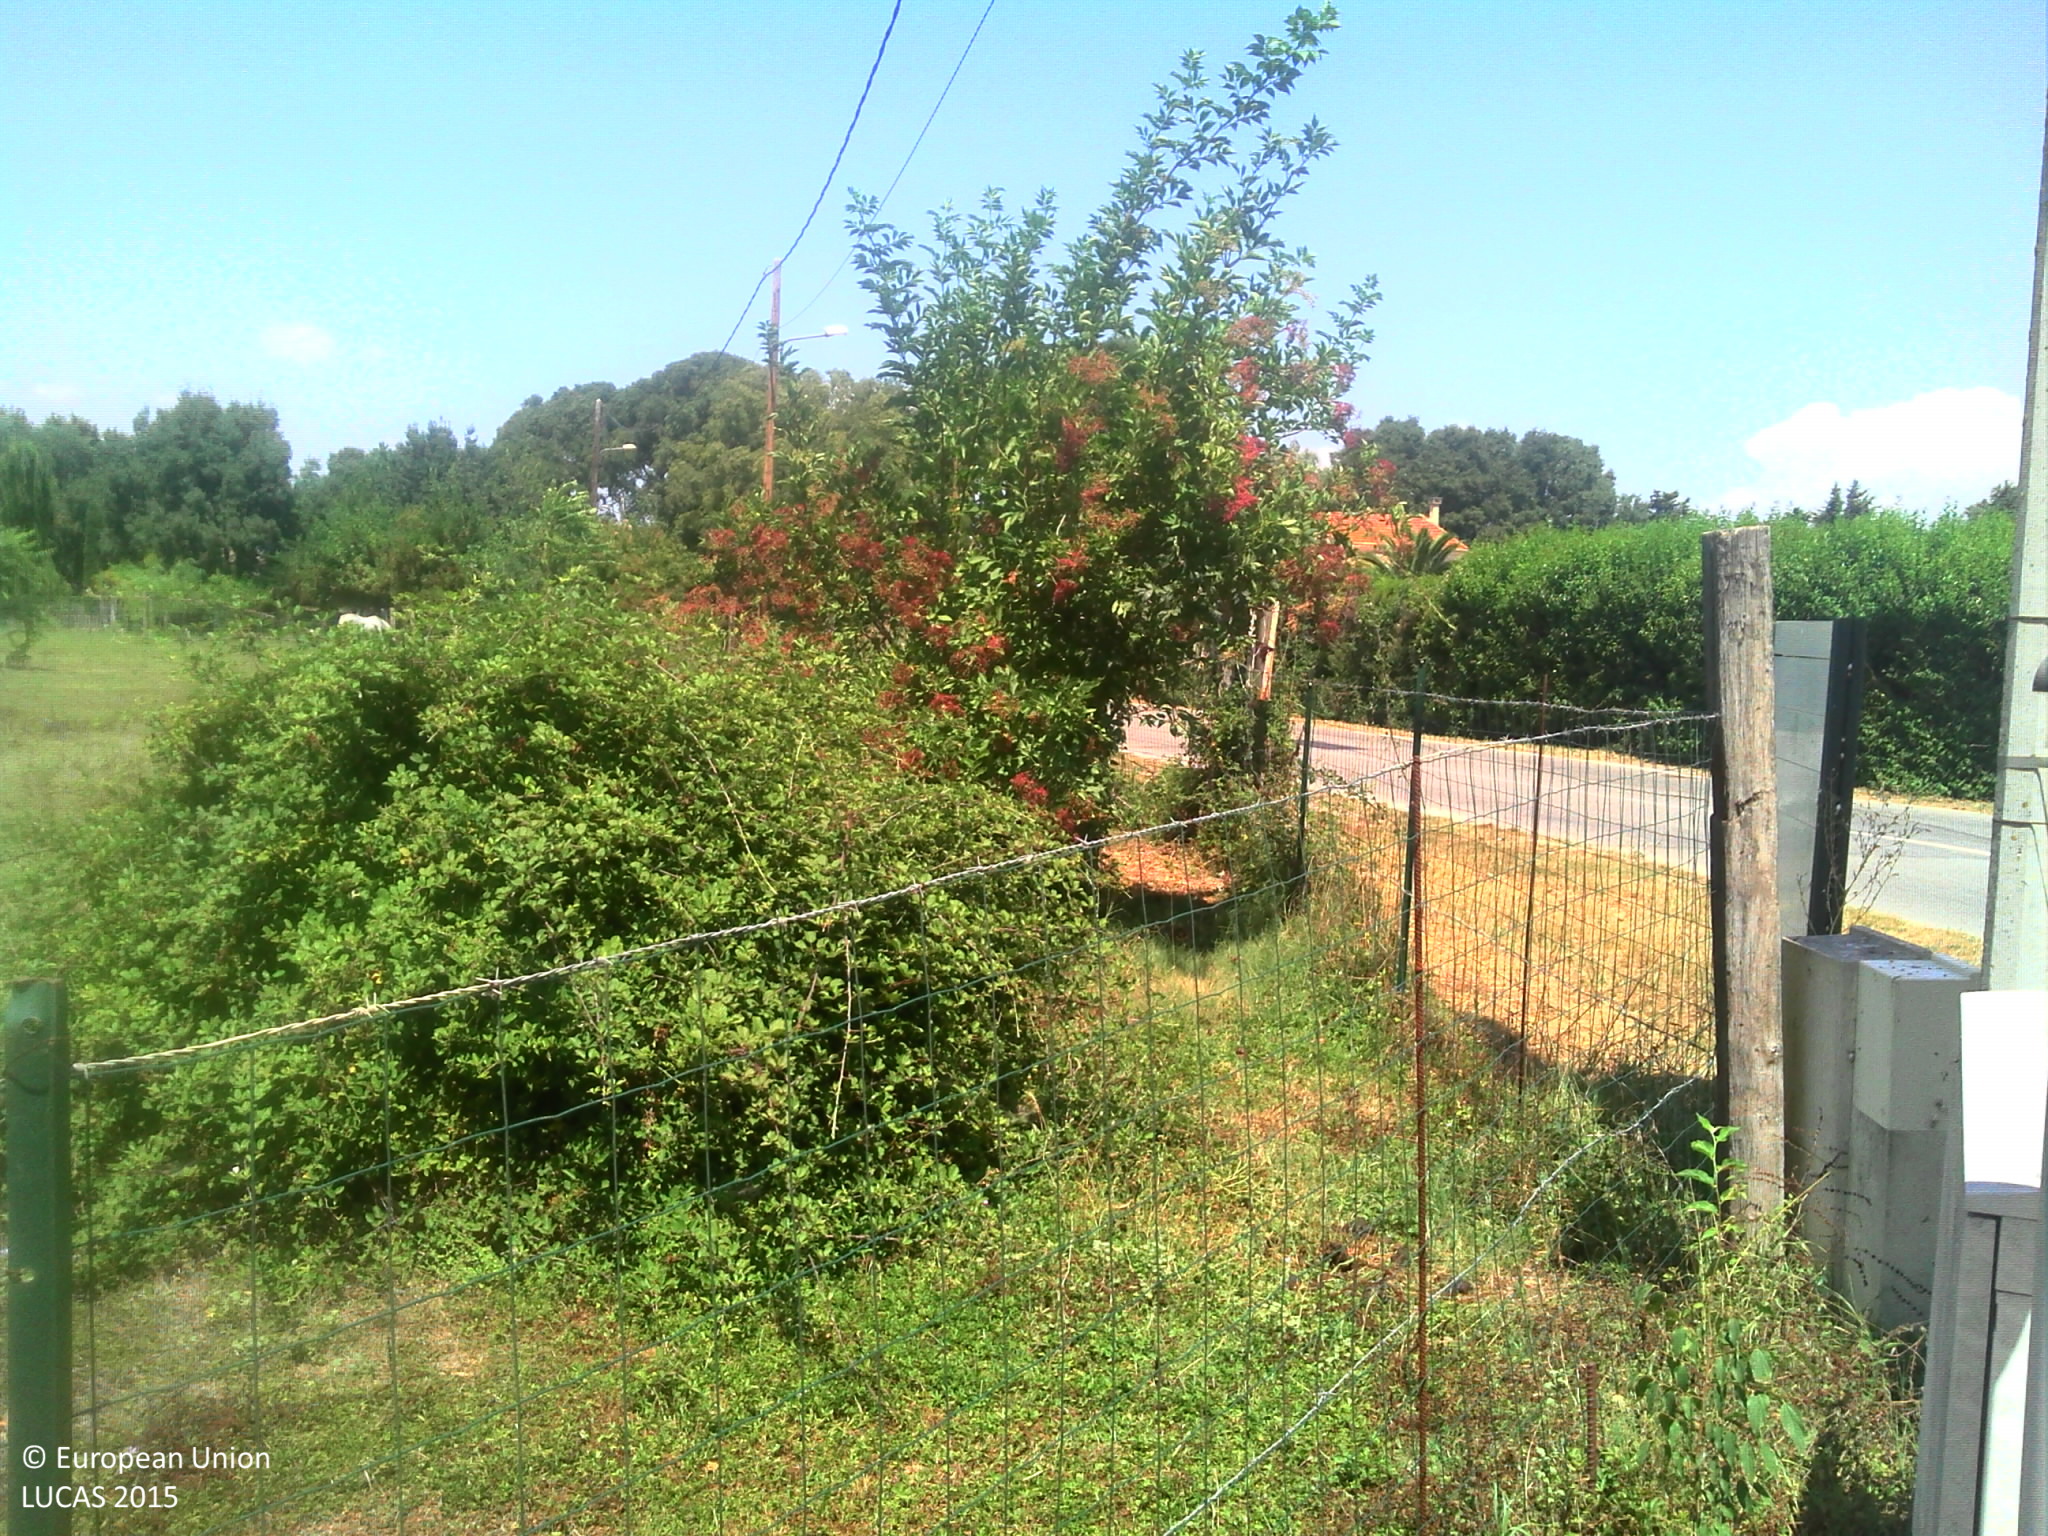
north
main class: Grassland
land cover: Grassland with sparse tree/shrub cover
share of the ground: > 75 %
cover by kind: herbaceous plants 90 %, coniferous forest trees 5 %, shrubs 5 %
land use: Agriculture (excluding fallow land and kitchen gardens)
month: July
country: FR
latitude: 43.6388
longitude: 4.7413
